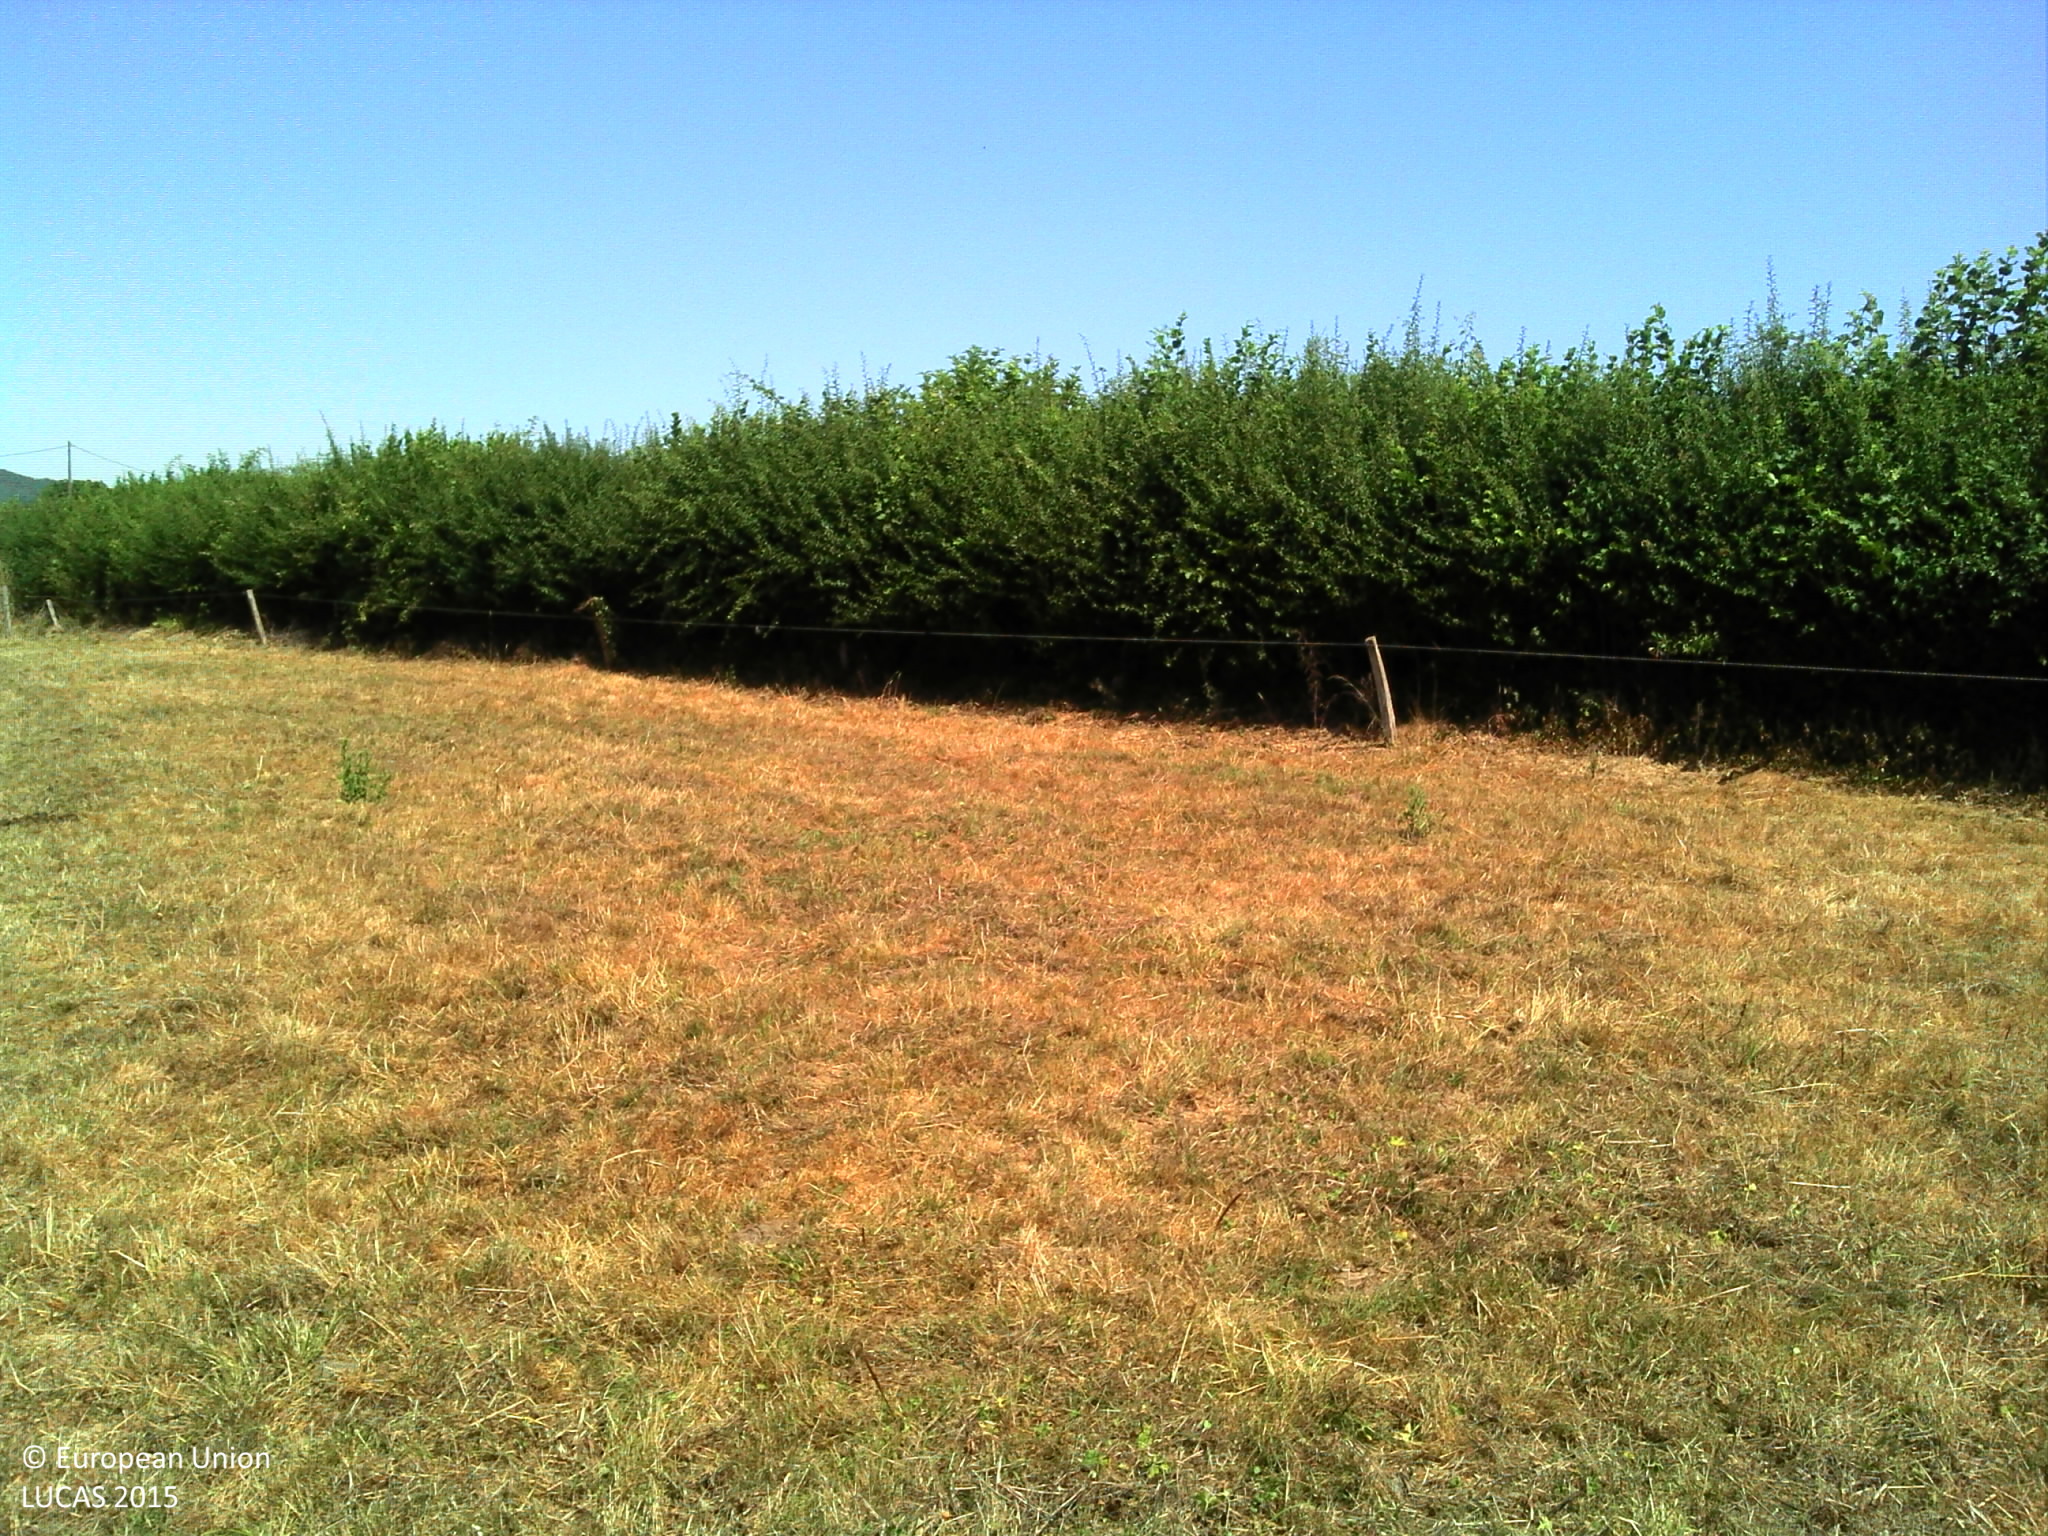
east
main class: Grassland
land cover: Grassland without tree/shrub cover
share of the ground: > 75 %
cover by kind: herbaceous plants 100 %
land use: Agriculture (excluding fallow land and kitchen gardens)
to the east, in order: Grassland without tree/shrub cover; Fences; Managed hedges; Fences; Grassland without tree/shrub cover; Fences; Managed hedges; Electric lines; Ditches and canals; Grass margins; Paved roads, cycling and walking lanes; Grass margins; Fences; Common wheat
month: July
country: FR
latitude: 46.7974
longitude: 4.0120
